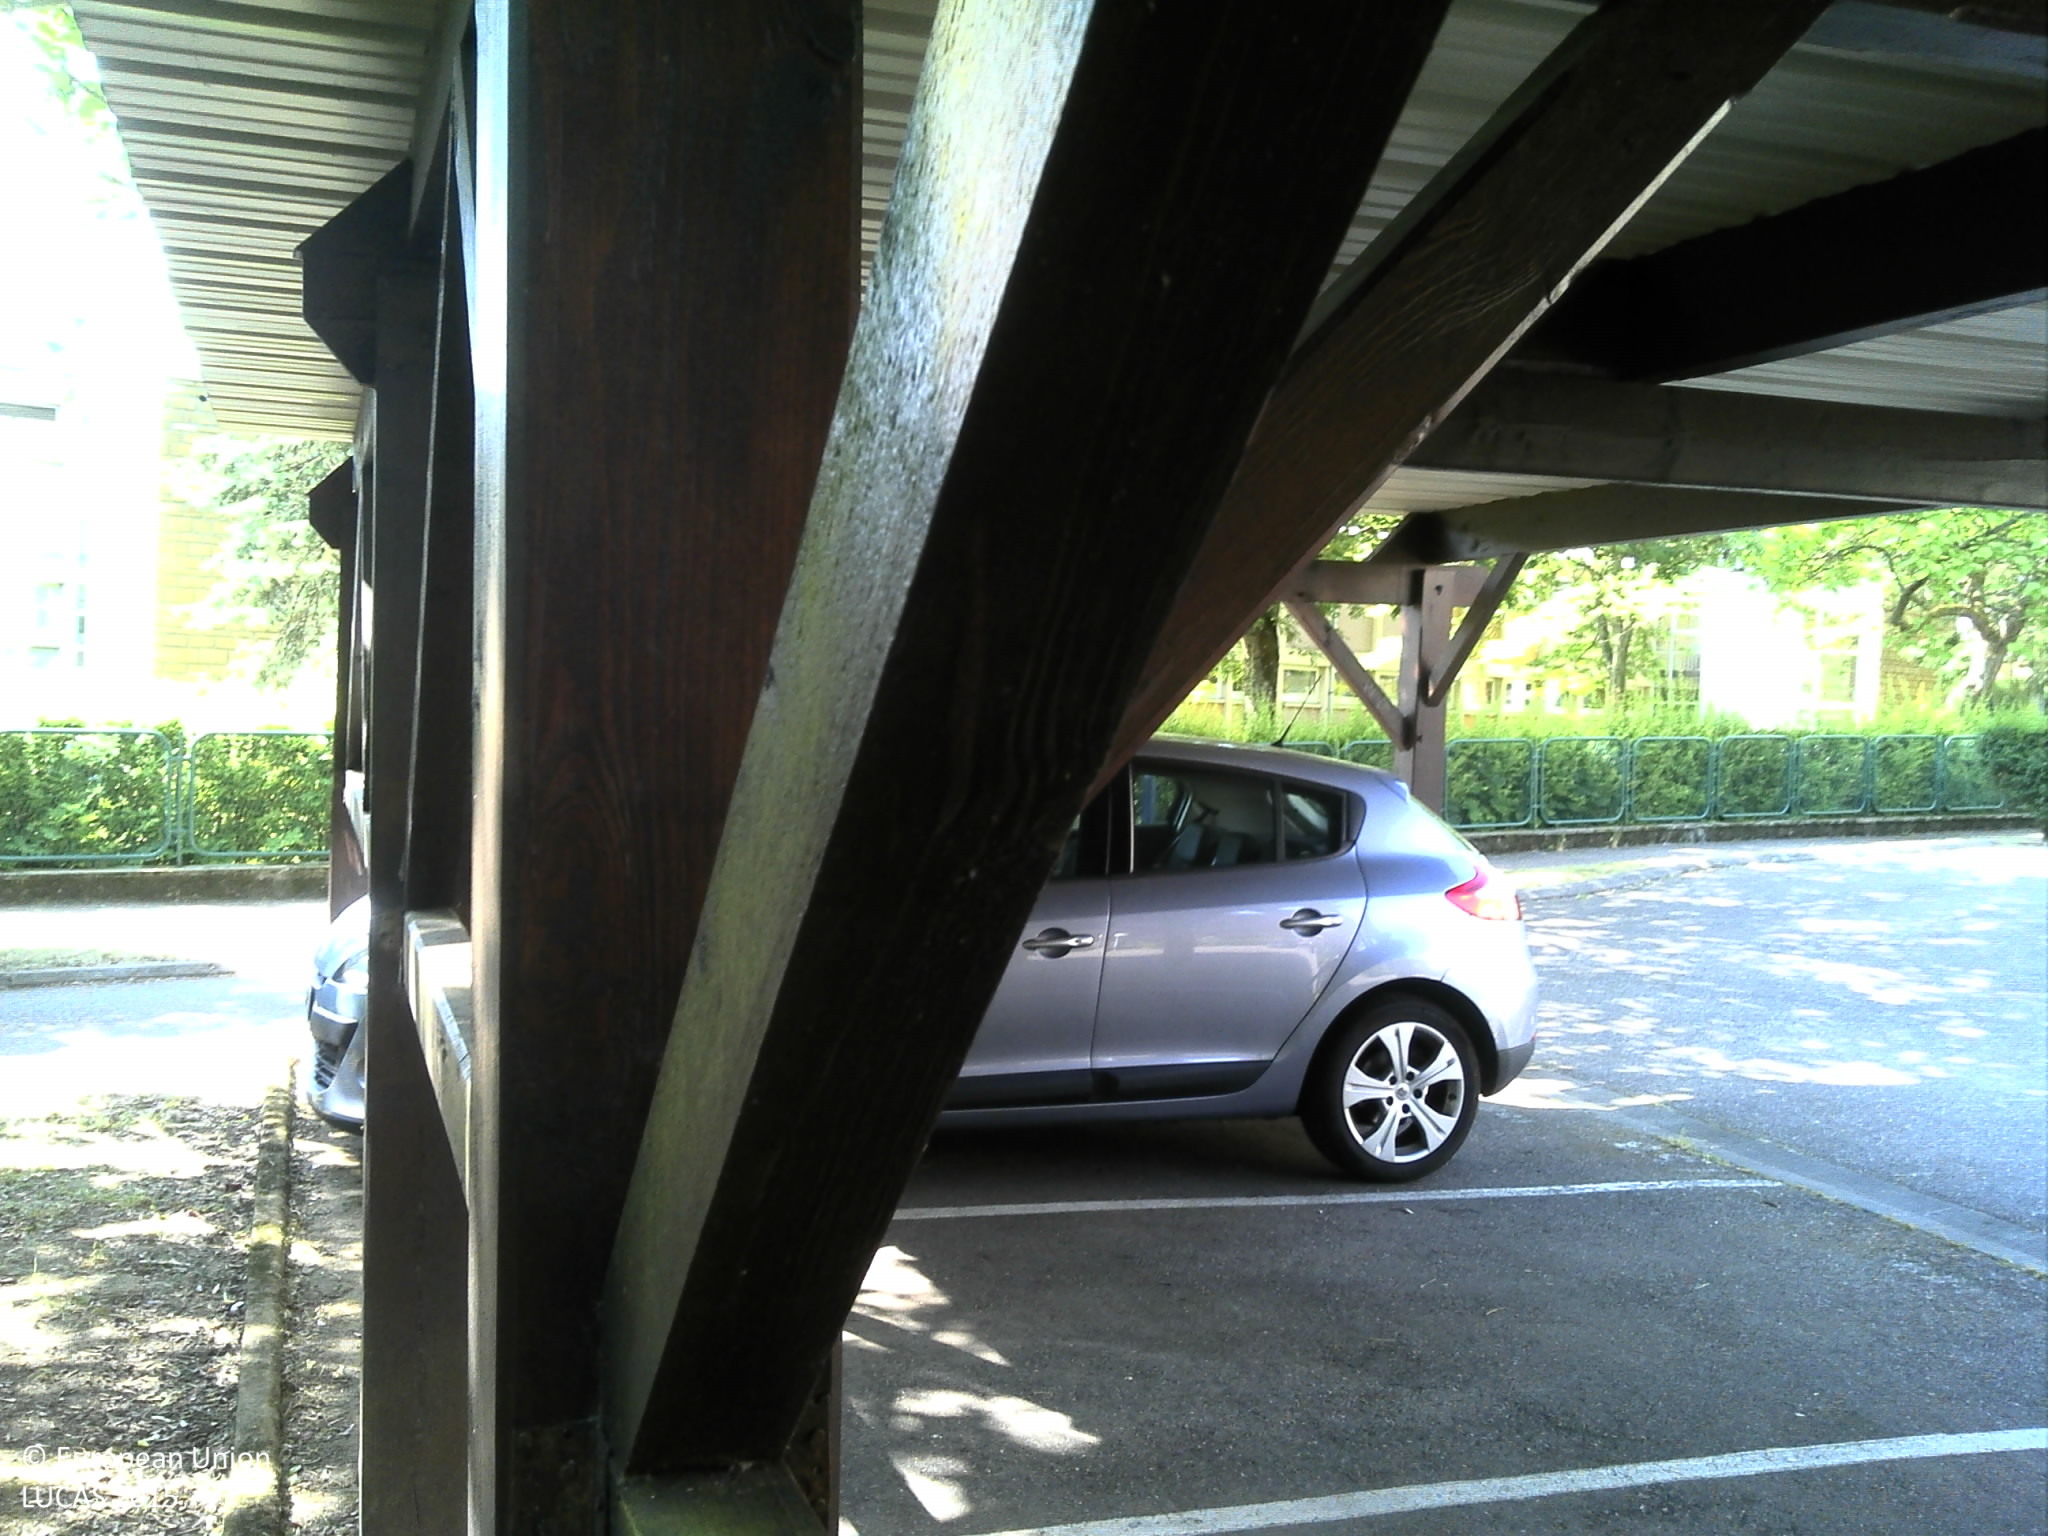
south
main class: Woodland
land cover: Broadleaved woodland
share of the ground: 25 - 50 %
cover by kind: herbaceous plants 60 %, broadleaved forest trees 40 %
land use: Residential
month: June
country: FR
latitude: 49.0939
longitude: 6.1789
